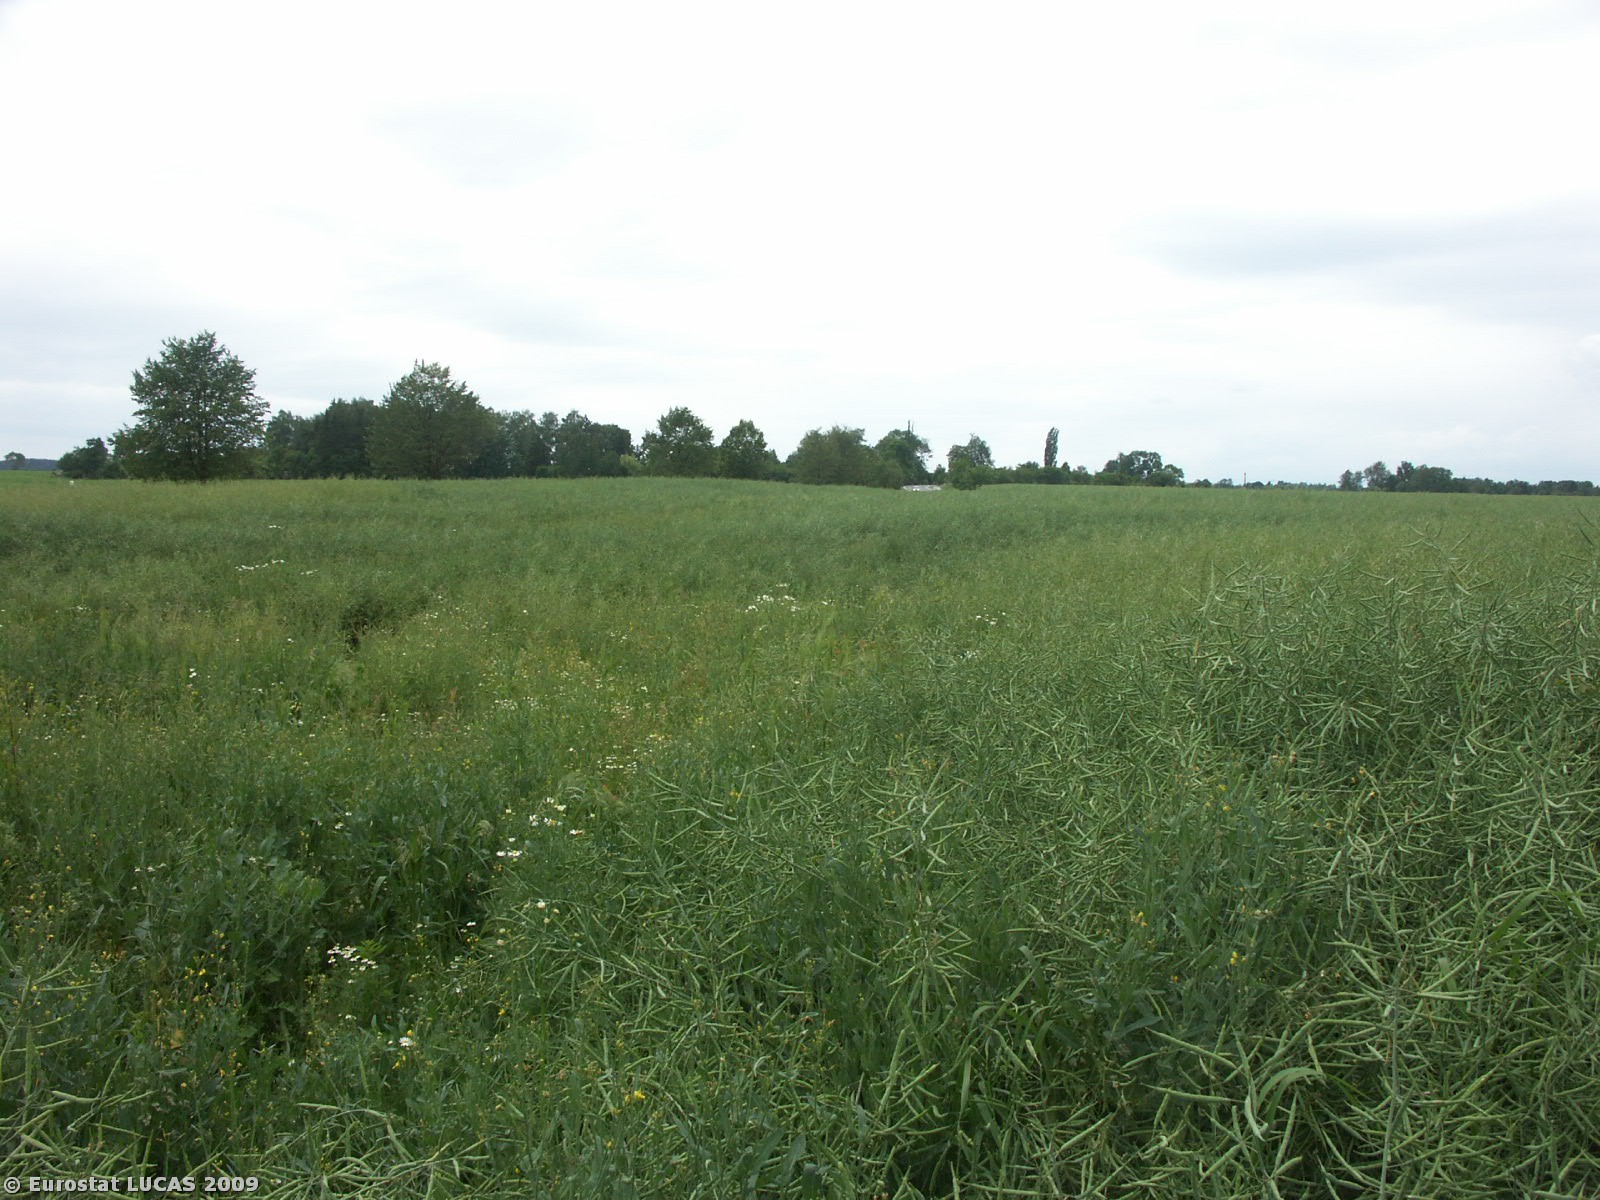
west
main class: Cropland
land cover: Rape and turnip rape
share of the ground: > 75 %
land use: Agriculture (excluding fallow land and kitchen gardens)
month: June
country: CZ
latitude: 49.0091
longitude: 14.6360
